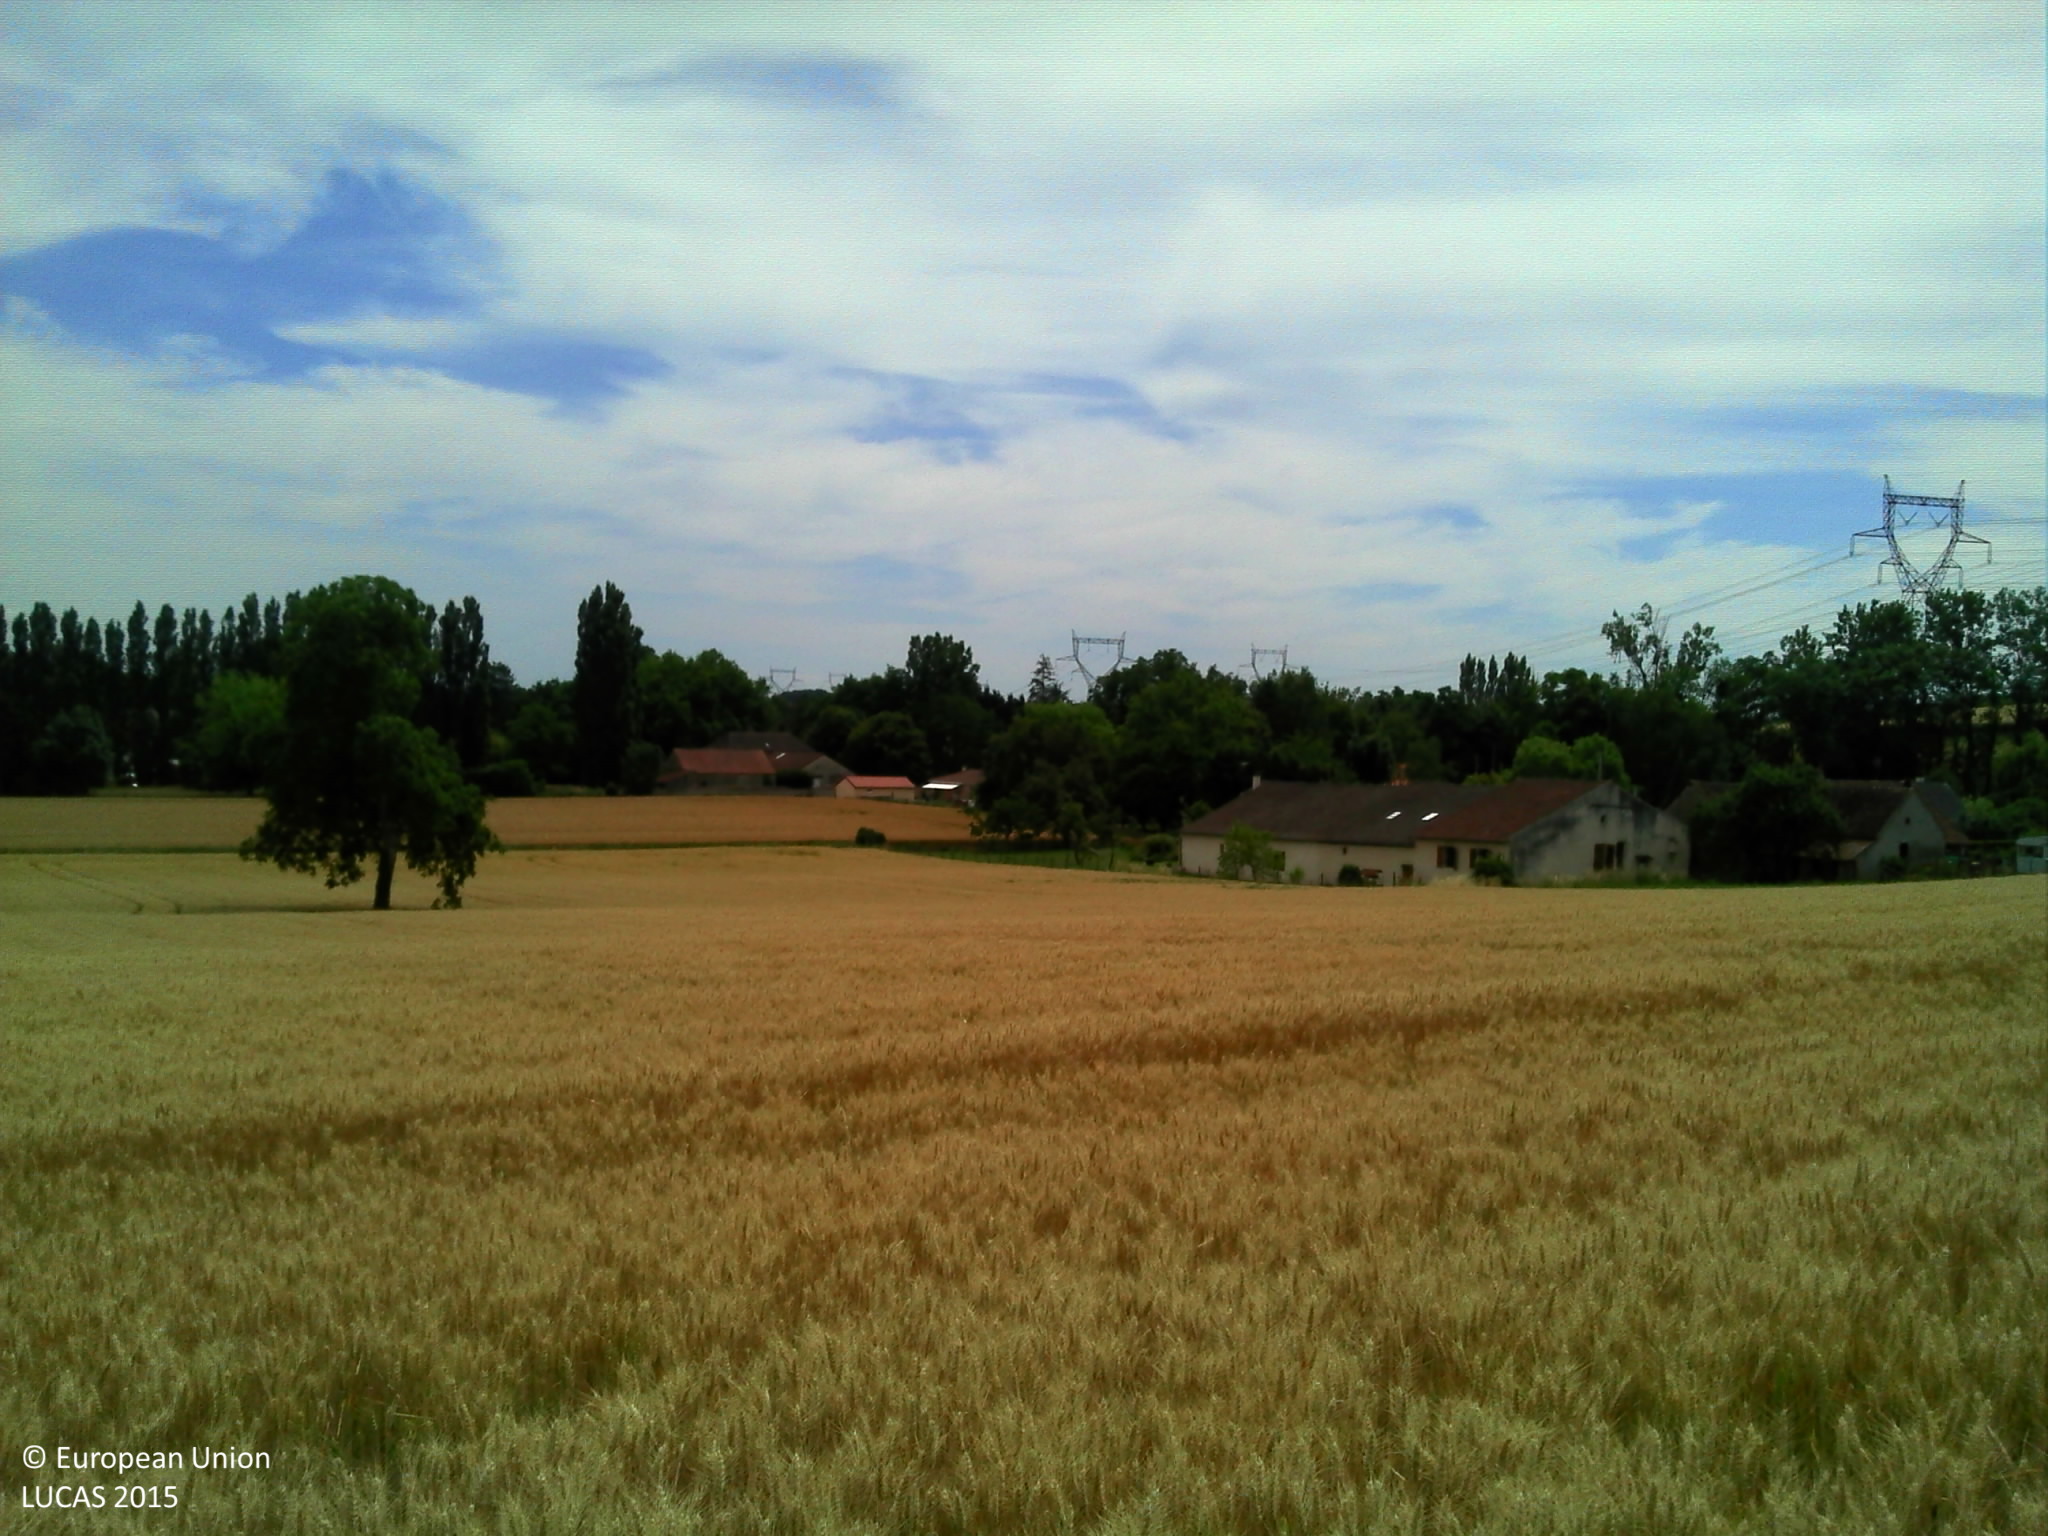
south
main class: Cropland
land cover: Common wheat
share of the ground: > 75 %
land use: Agriculture (excluding fallow land and kitchen gardens)
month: June
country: FR
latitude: 46.3191
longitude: 3.2582
